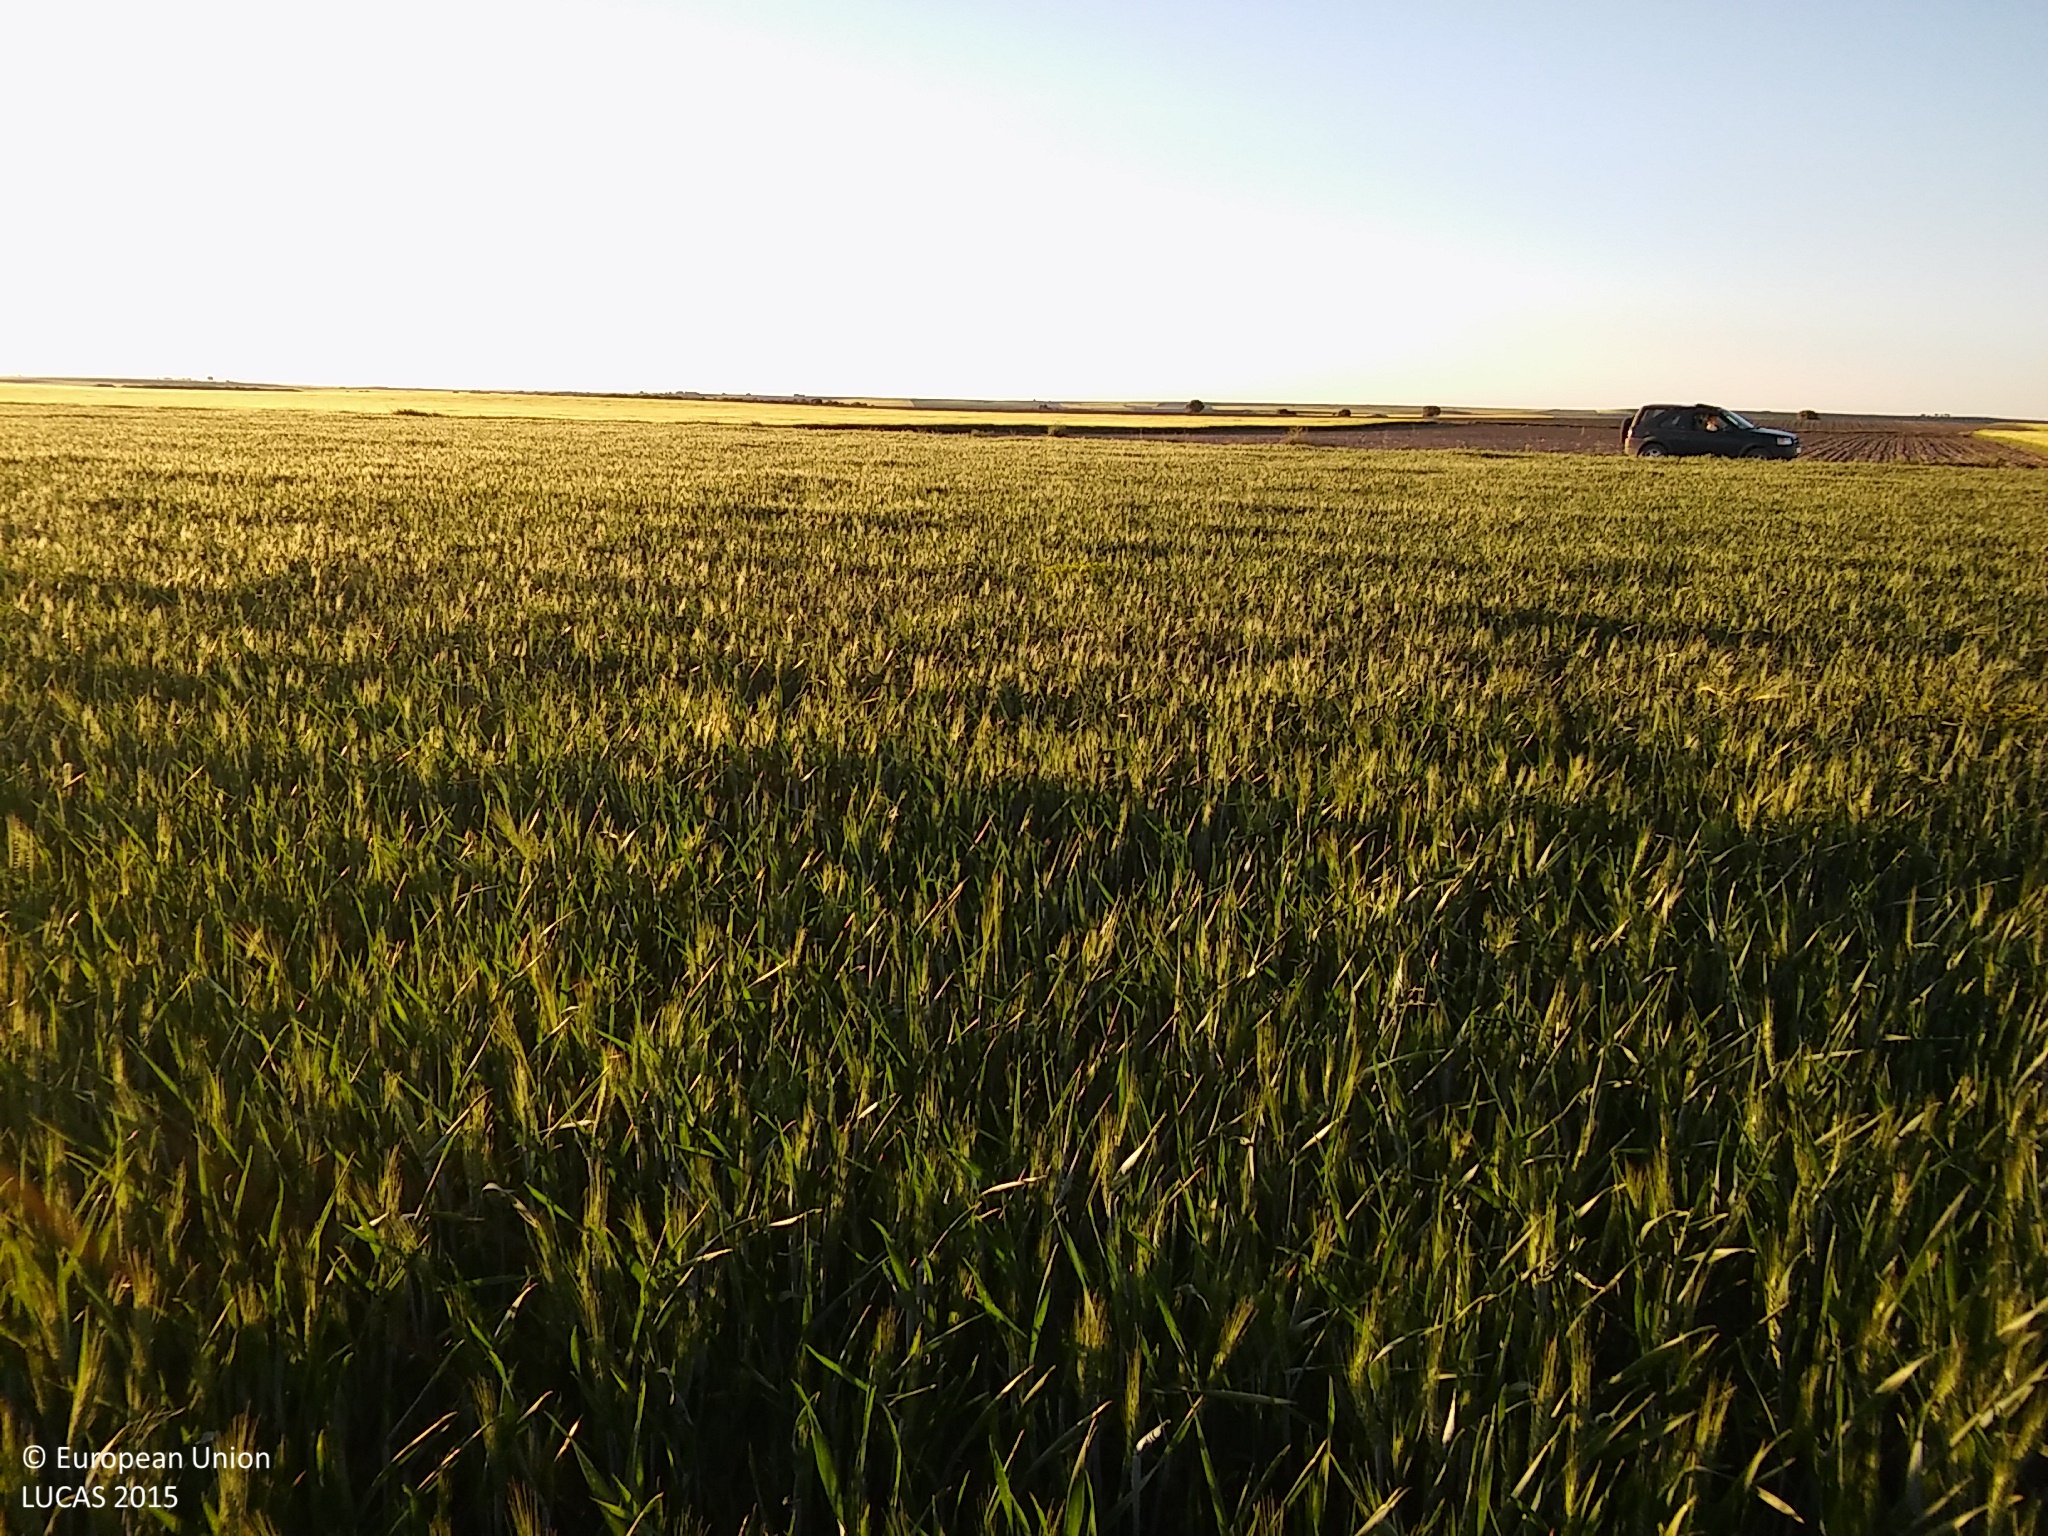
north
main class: Cropland
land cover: Common wheat
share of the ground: > 75 %
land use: Agriculture (excluding fallow land and kitchen gardens)
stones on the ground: 25 - 50 %
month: May
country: ES
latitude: 41.3998
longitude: -4.0129
